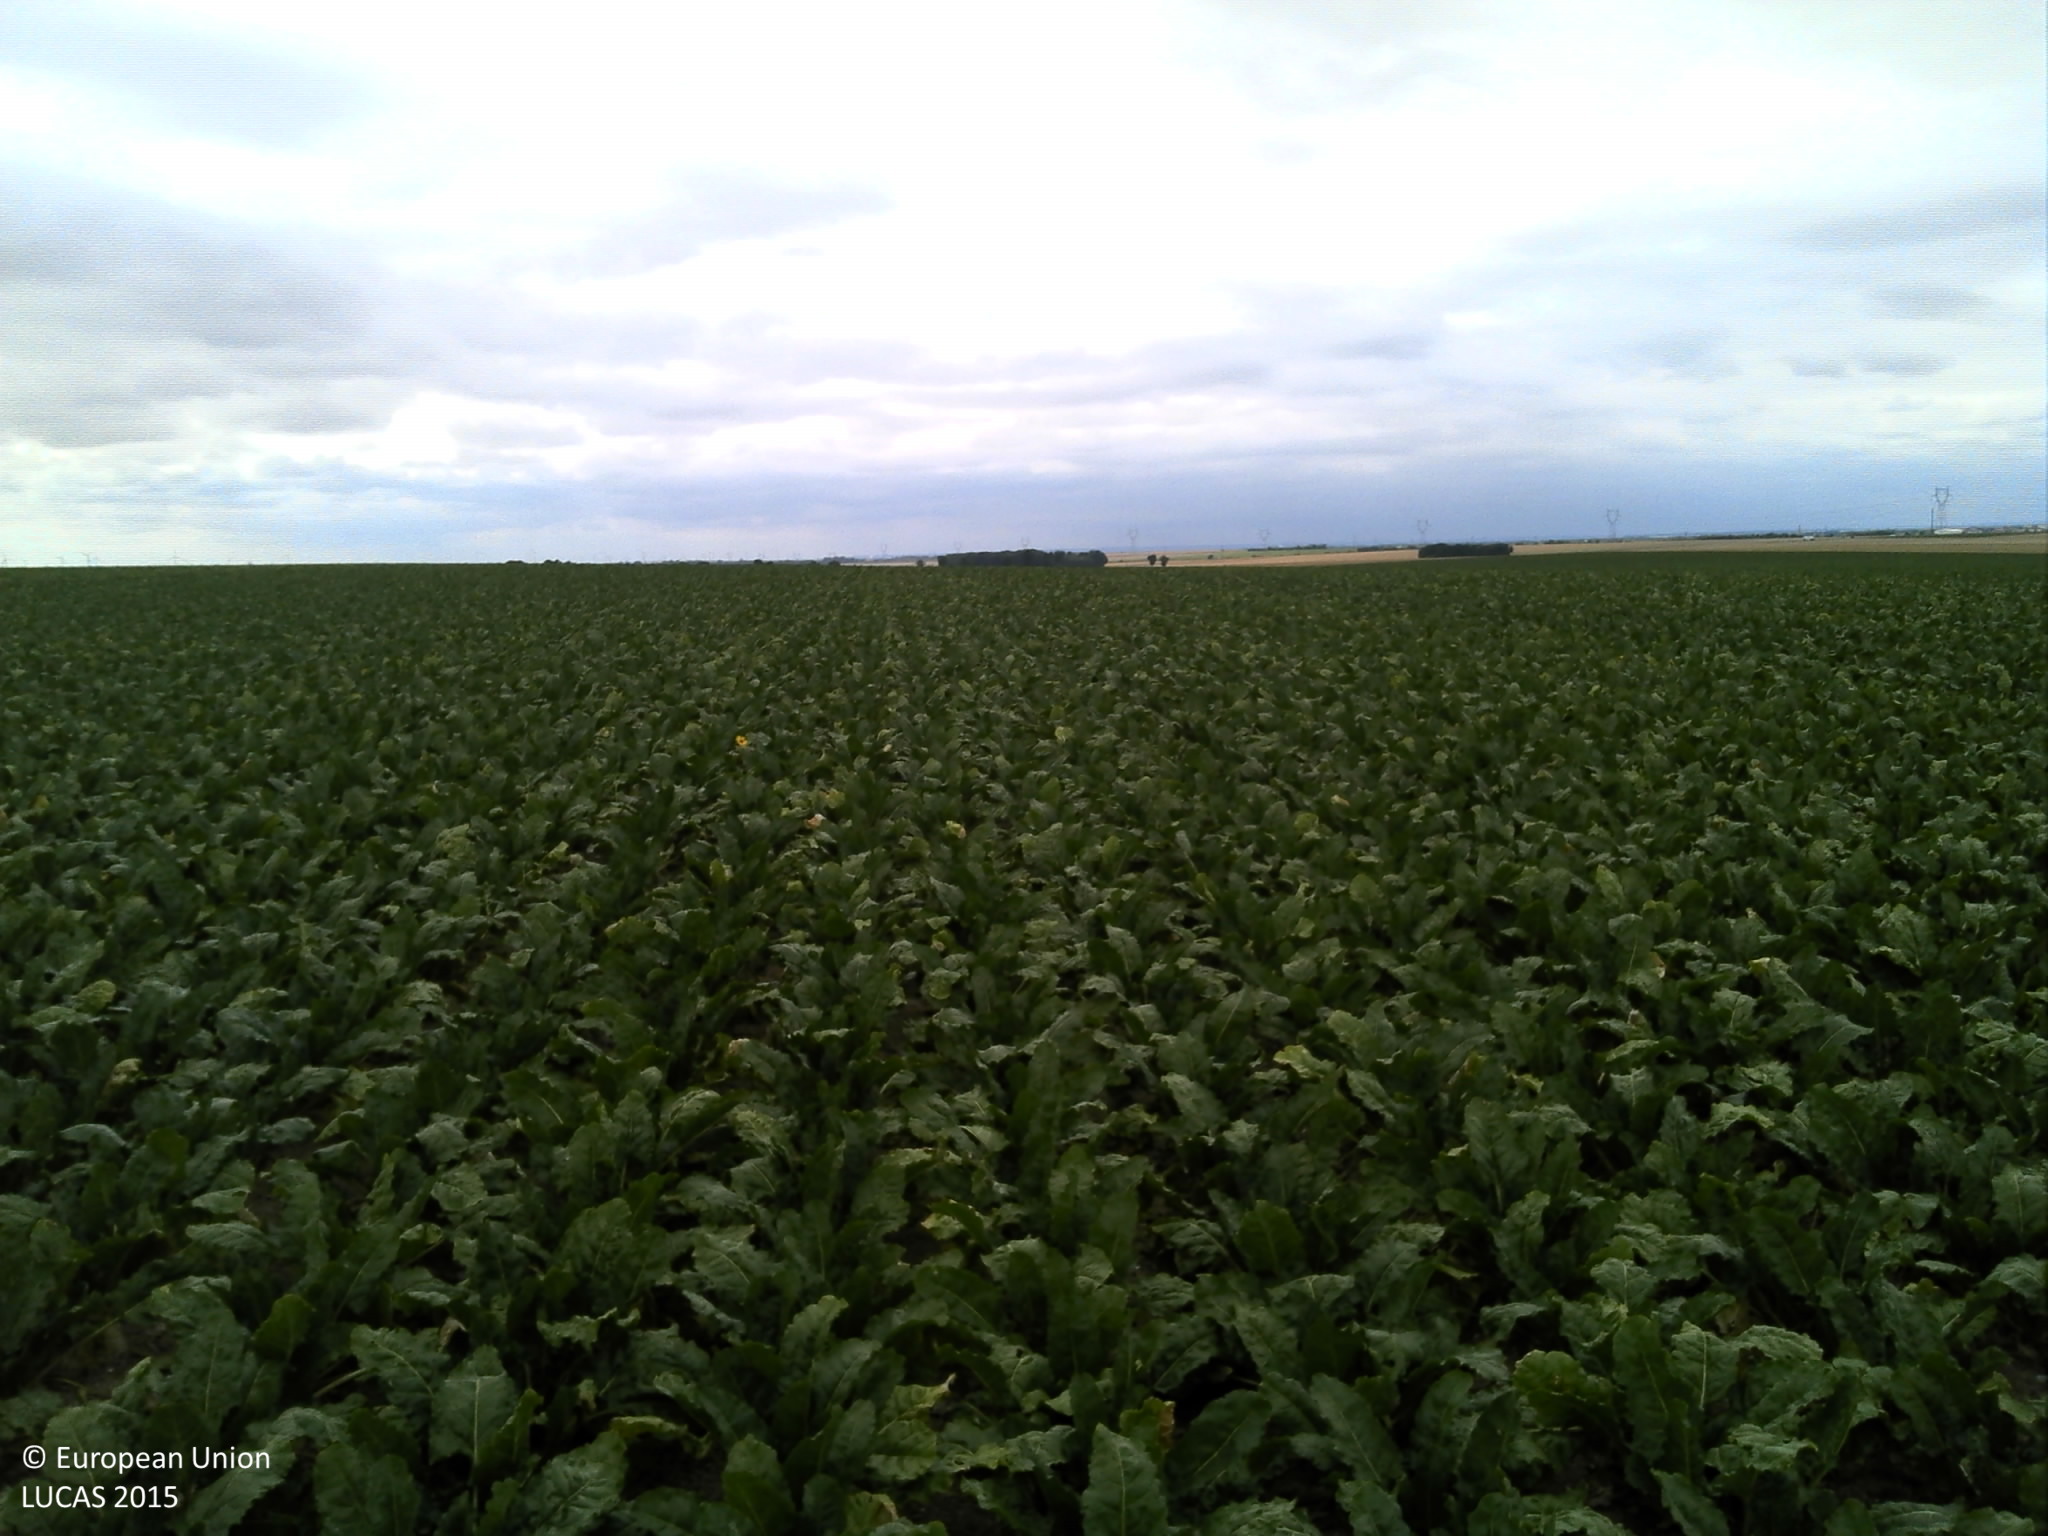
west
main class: Cropland
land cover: Sugar beet
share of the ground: > 75 %
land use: Agriculture (excluding fallow land and kitchen gardens)
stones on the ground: < 10 %
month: August
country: FR
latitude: 48.5019
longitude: 4.1630
